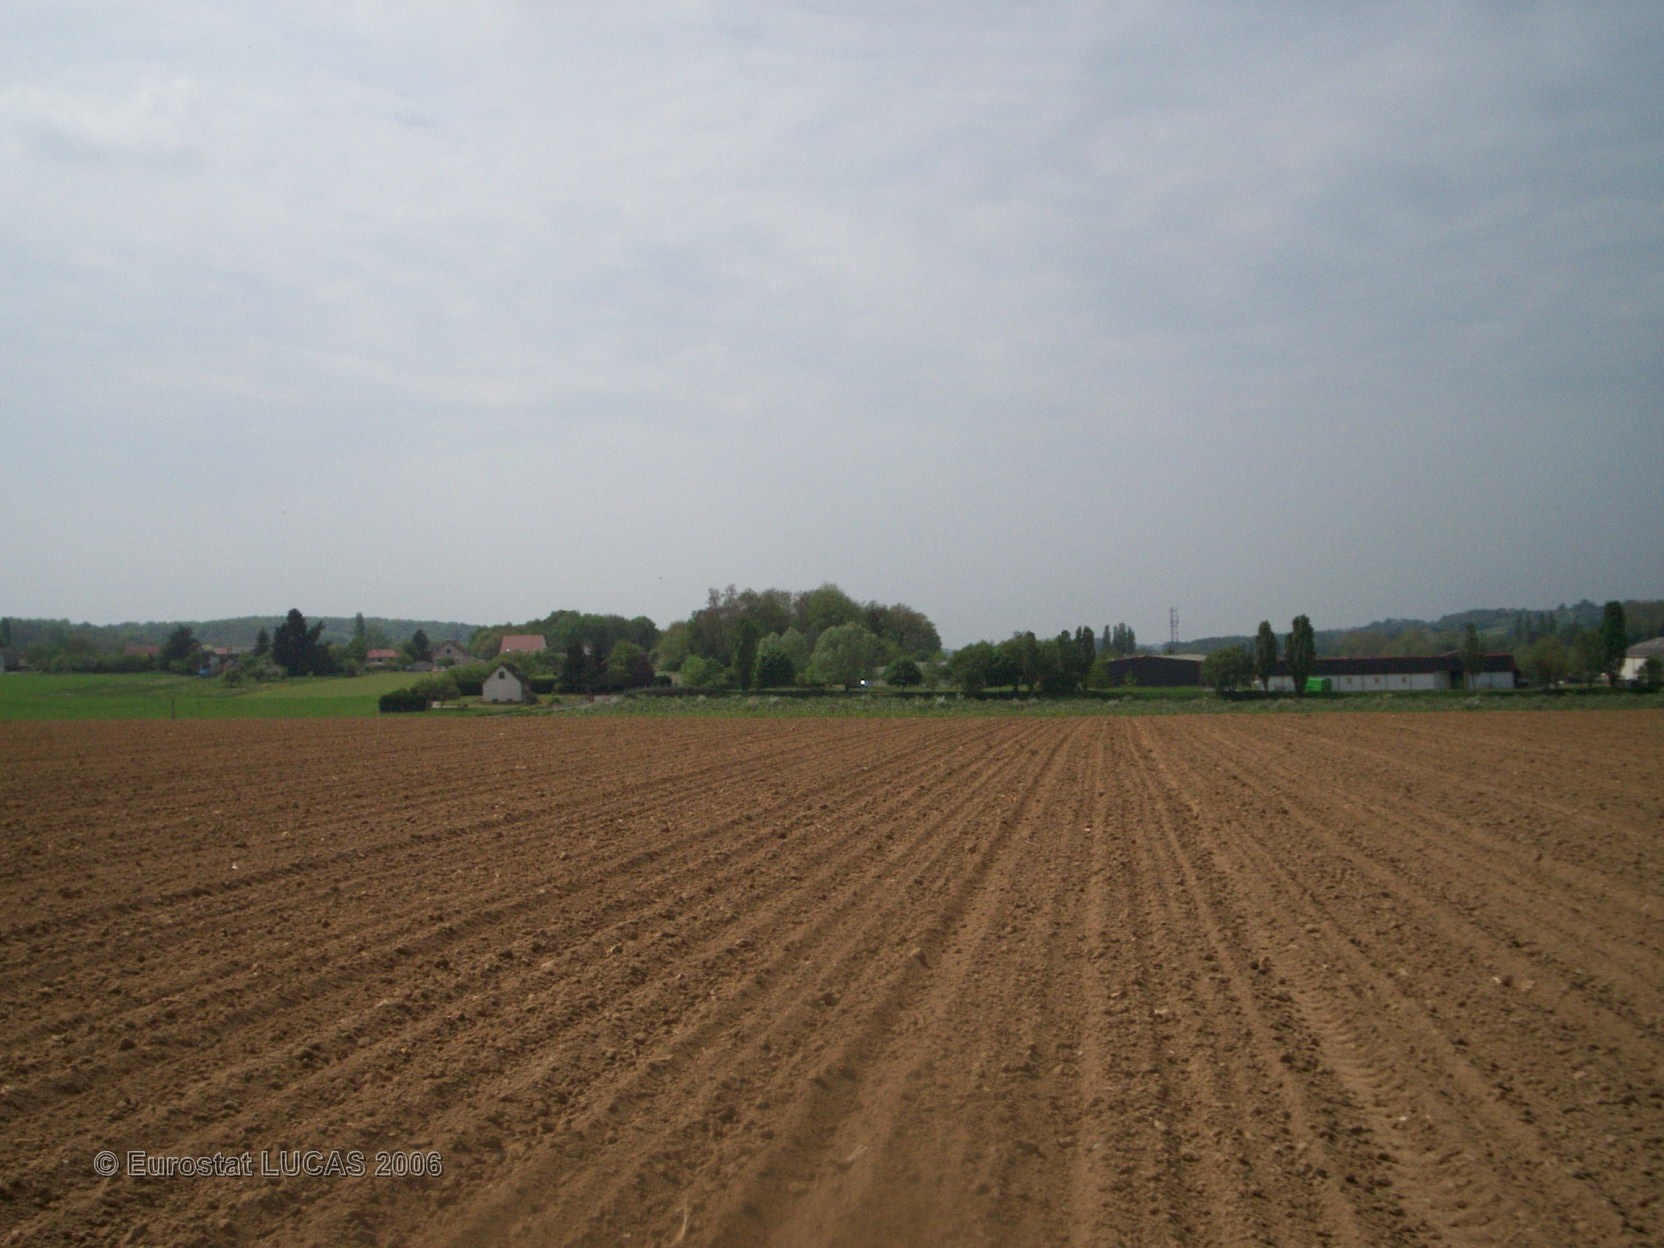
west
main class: Cropland
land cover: Maize
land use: Agriculture (excluding fallow land and kitchen gardens)
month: May
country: FR
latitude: 47.9248
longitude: 2.9399
